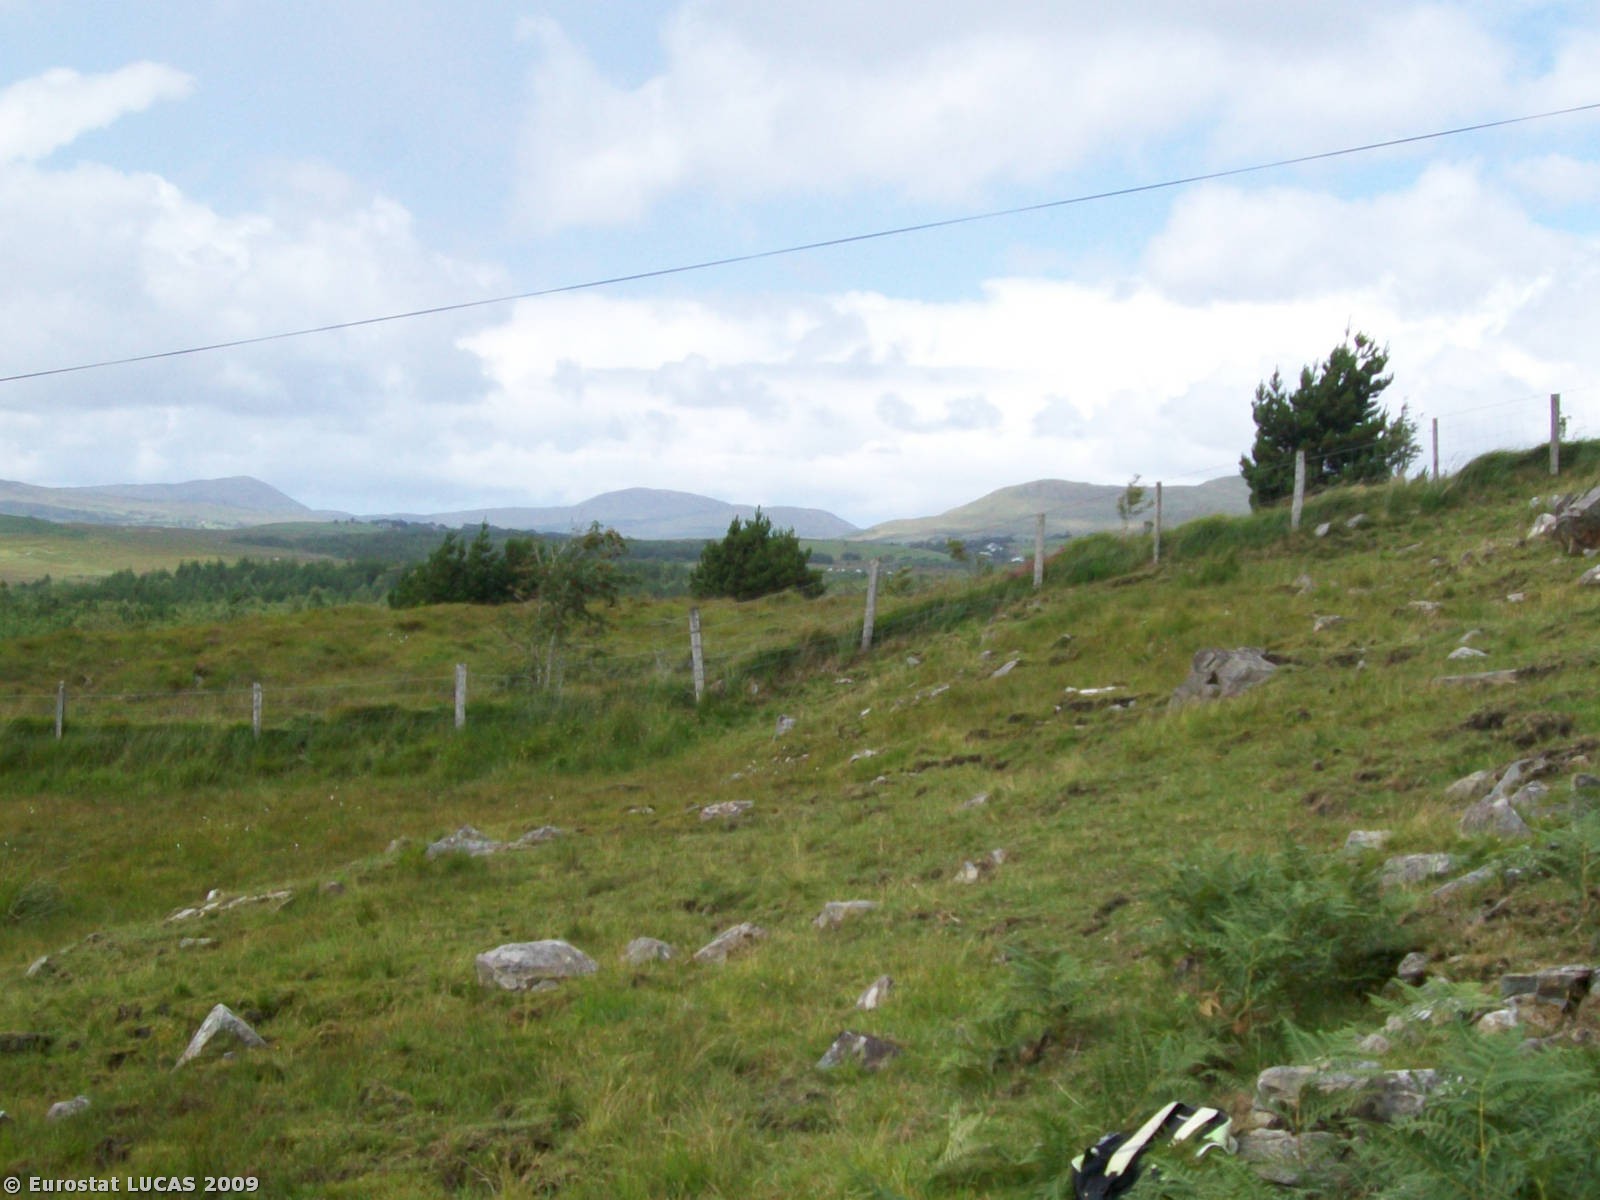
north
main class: Grassland
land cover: Grassland without tree/shrub cover
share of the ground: > 75 %
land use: Agriculture (excluding fallow land and kitchen gardens)
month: July
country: IE
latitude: 53.6955
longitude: -9.5443
